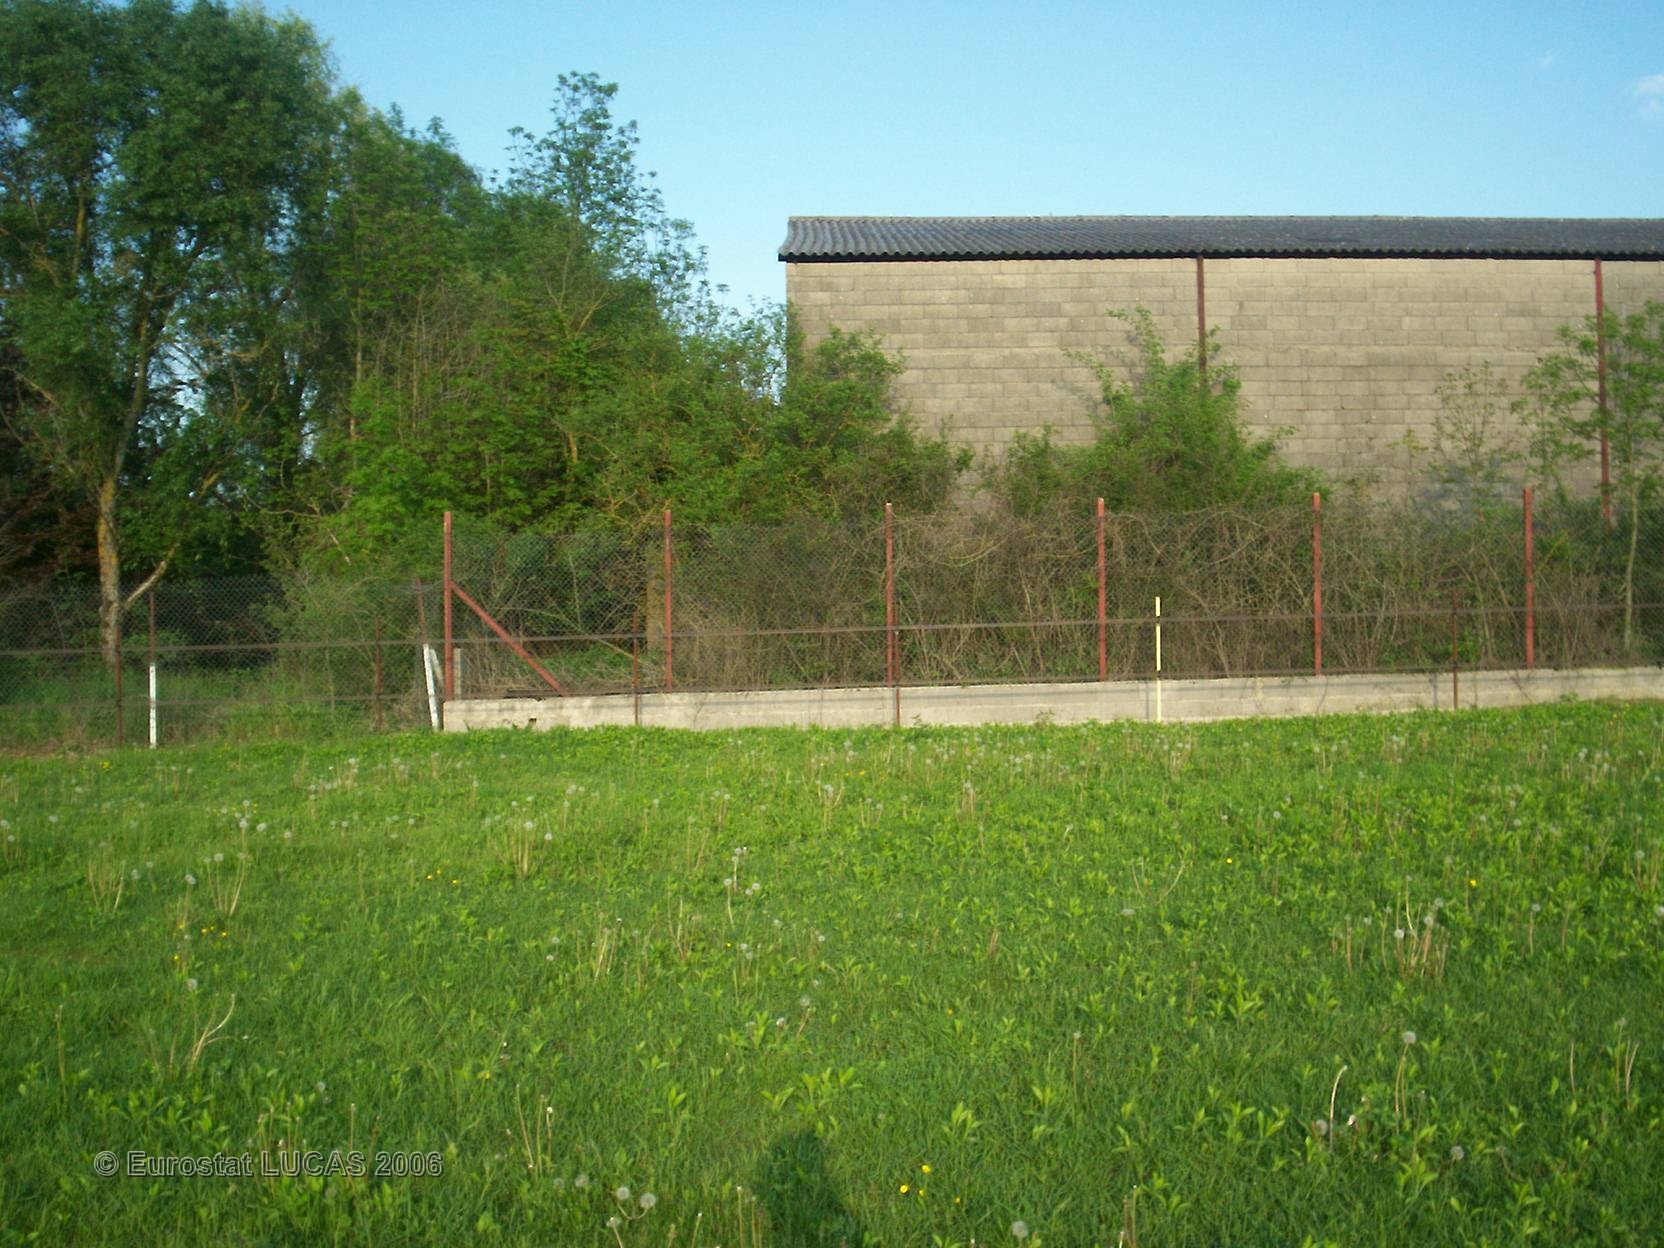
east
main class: Grassland
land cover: Grassland without tree/shrub cover
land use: Agriculture (excluding fallow land and kitchen gardens)
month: May
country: FR
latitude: 47.8547
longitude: 4.5588
